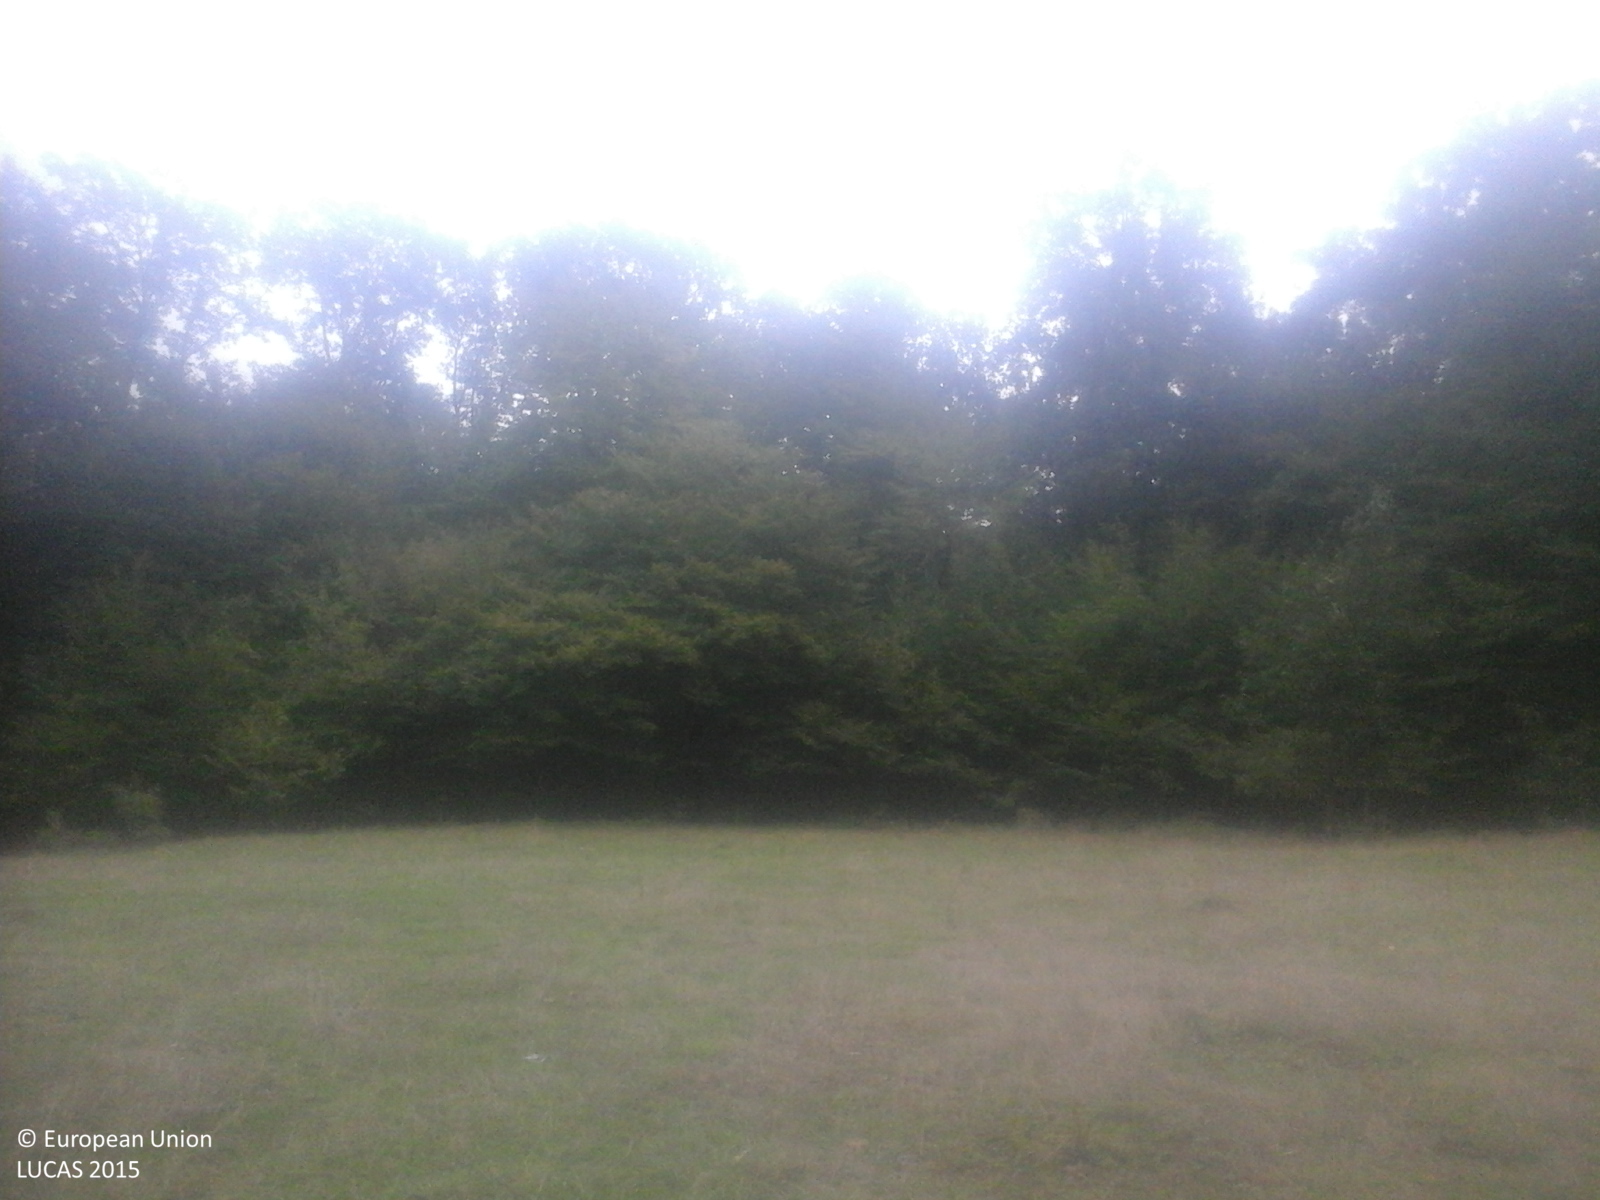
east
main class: Grassland
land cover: Grassland without tree/shrub cover
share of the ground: > 75 %
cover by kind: herbaceous plants 100 %
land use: Agriculture (excluding fallow land and kitchen gardens)
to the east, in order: Grassland without tree/shrub cover; Broadleaved woodland; Grassland with sparse tree/shrub cover; Broadleaved woodland; Grassland without tree/shrub cover; Tracks; Grassland without tree/shrub cover; Ditches and canals; Lines of trees; Grassland without tree/shrub cover; Broadleaved woodland
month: September
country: RO
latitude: 45.9190
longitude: 23.4335
